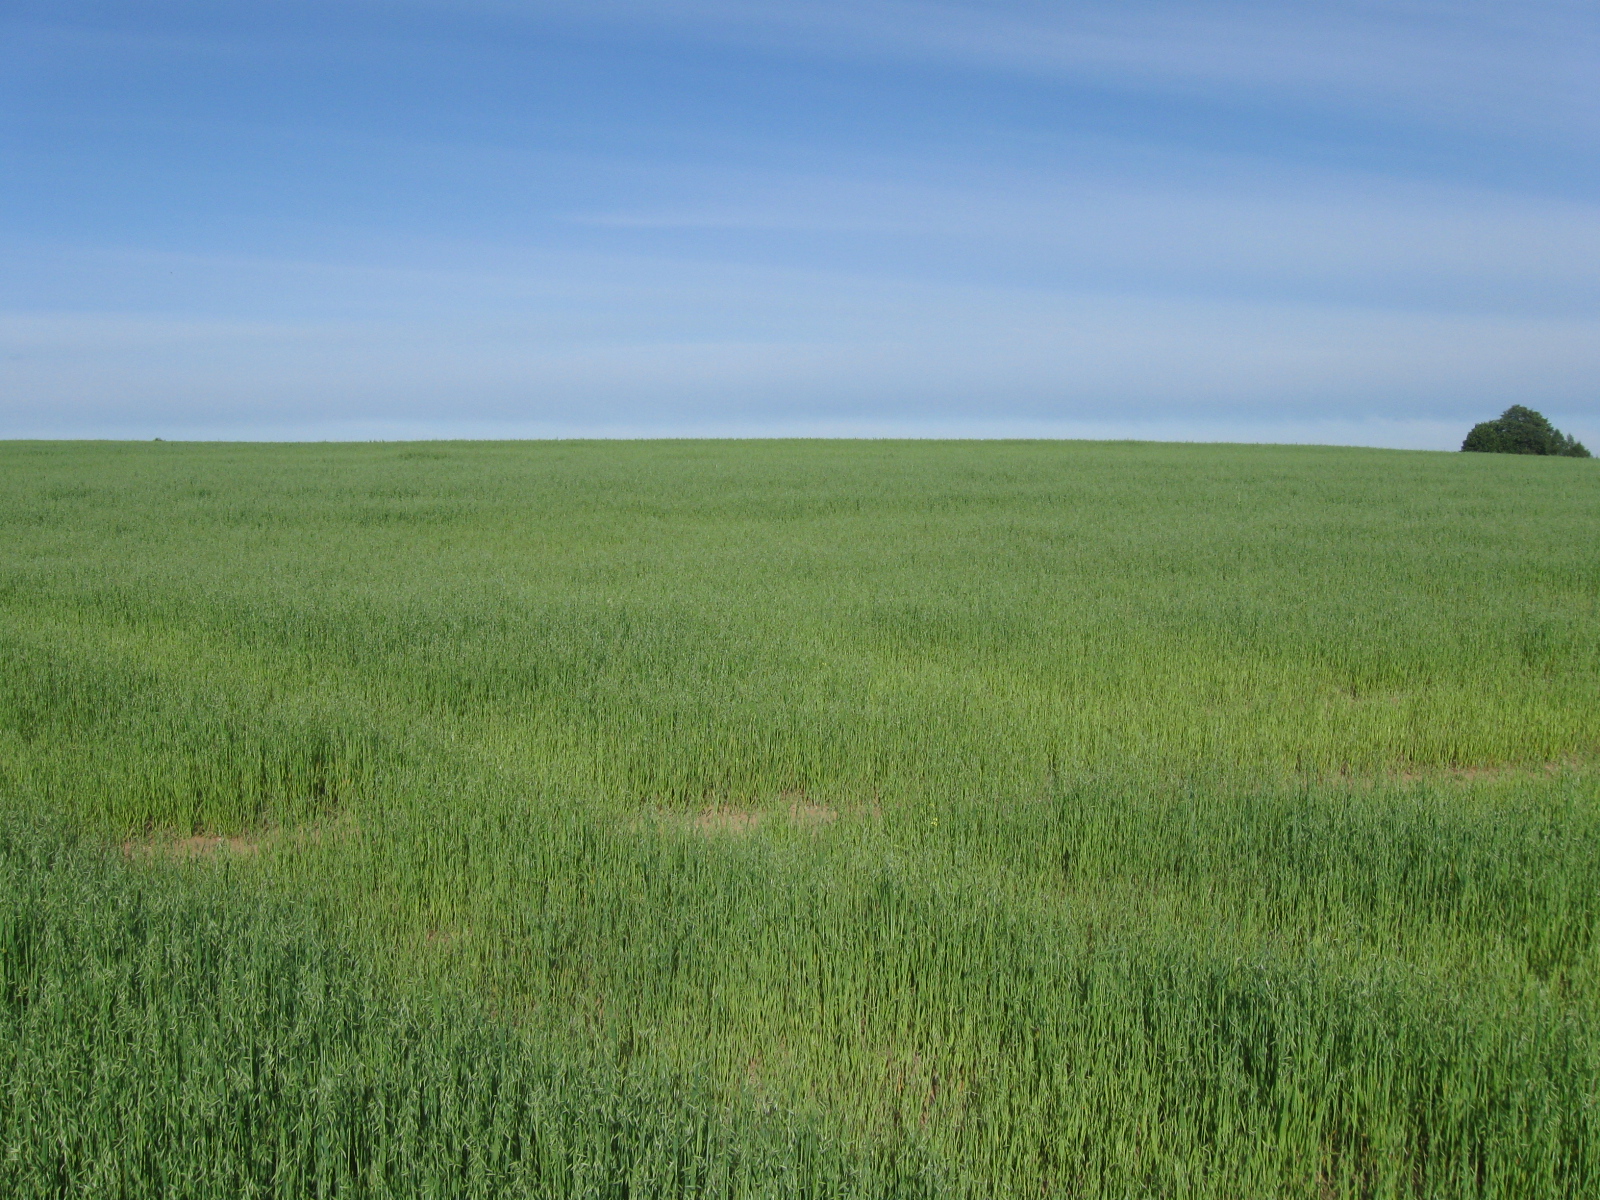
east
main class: Cropland
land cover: Oats
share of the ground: > 75 %
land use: Agriculture (excluding fallow land and kitchen gardens)
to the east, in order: Oats
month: June
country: LT
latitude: 54.1727
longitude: 24.7704
